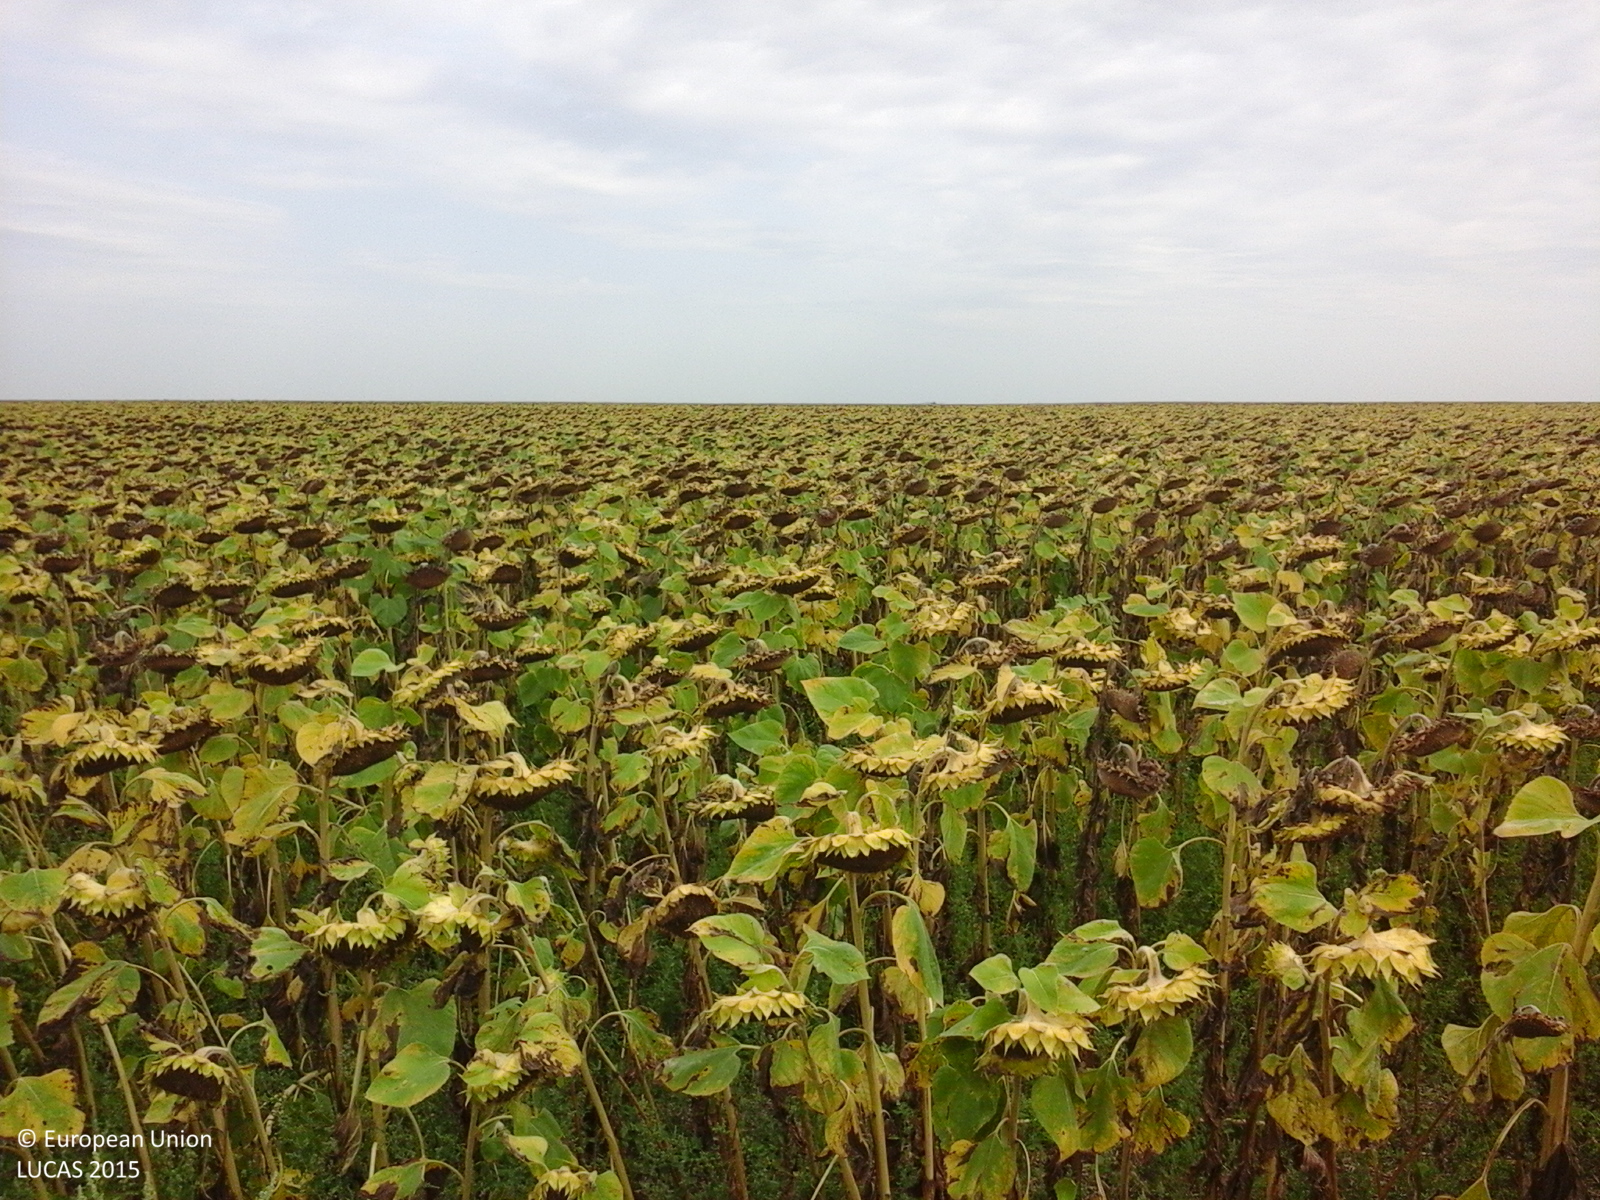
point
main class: Cropland
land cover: Sunflower
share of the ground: > 75 %
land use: Agriculture (excluding fallow land and kitchen gardens)
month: August
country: RO
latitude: 43.9533
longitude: 28.4456
